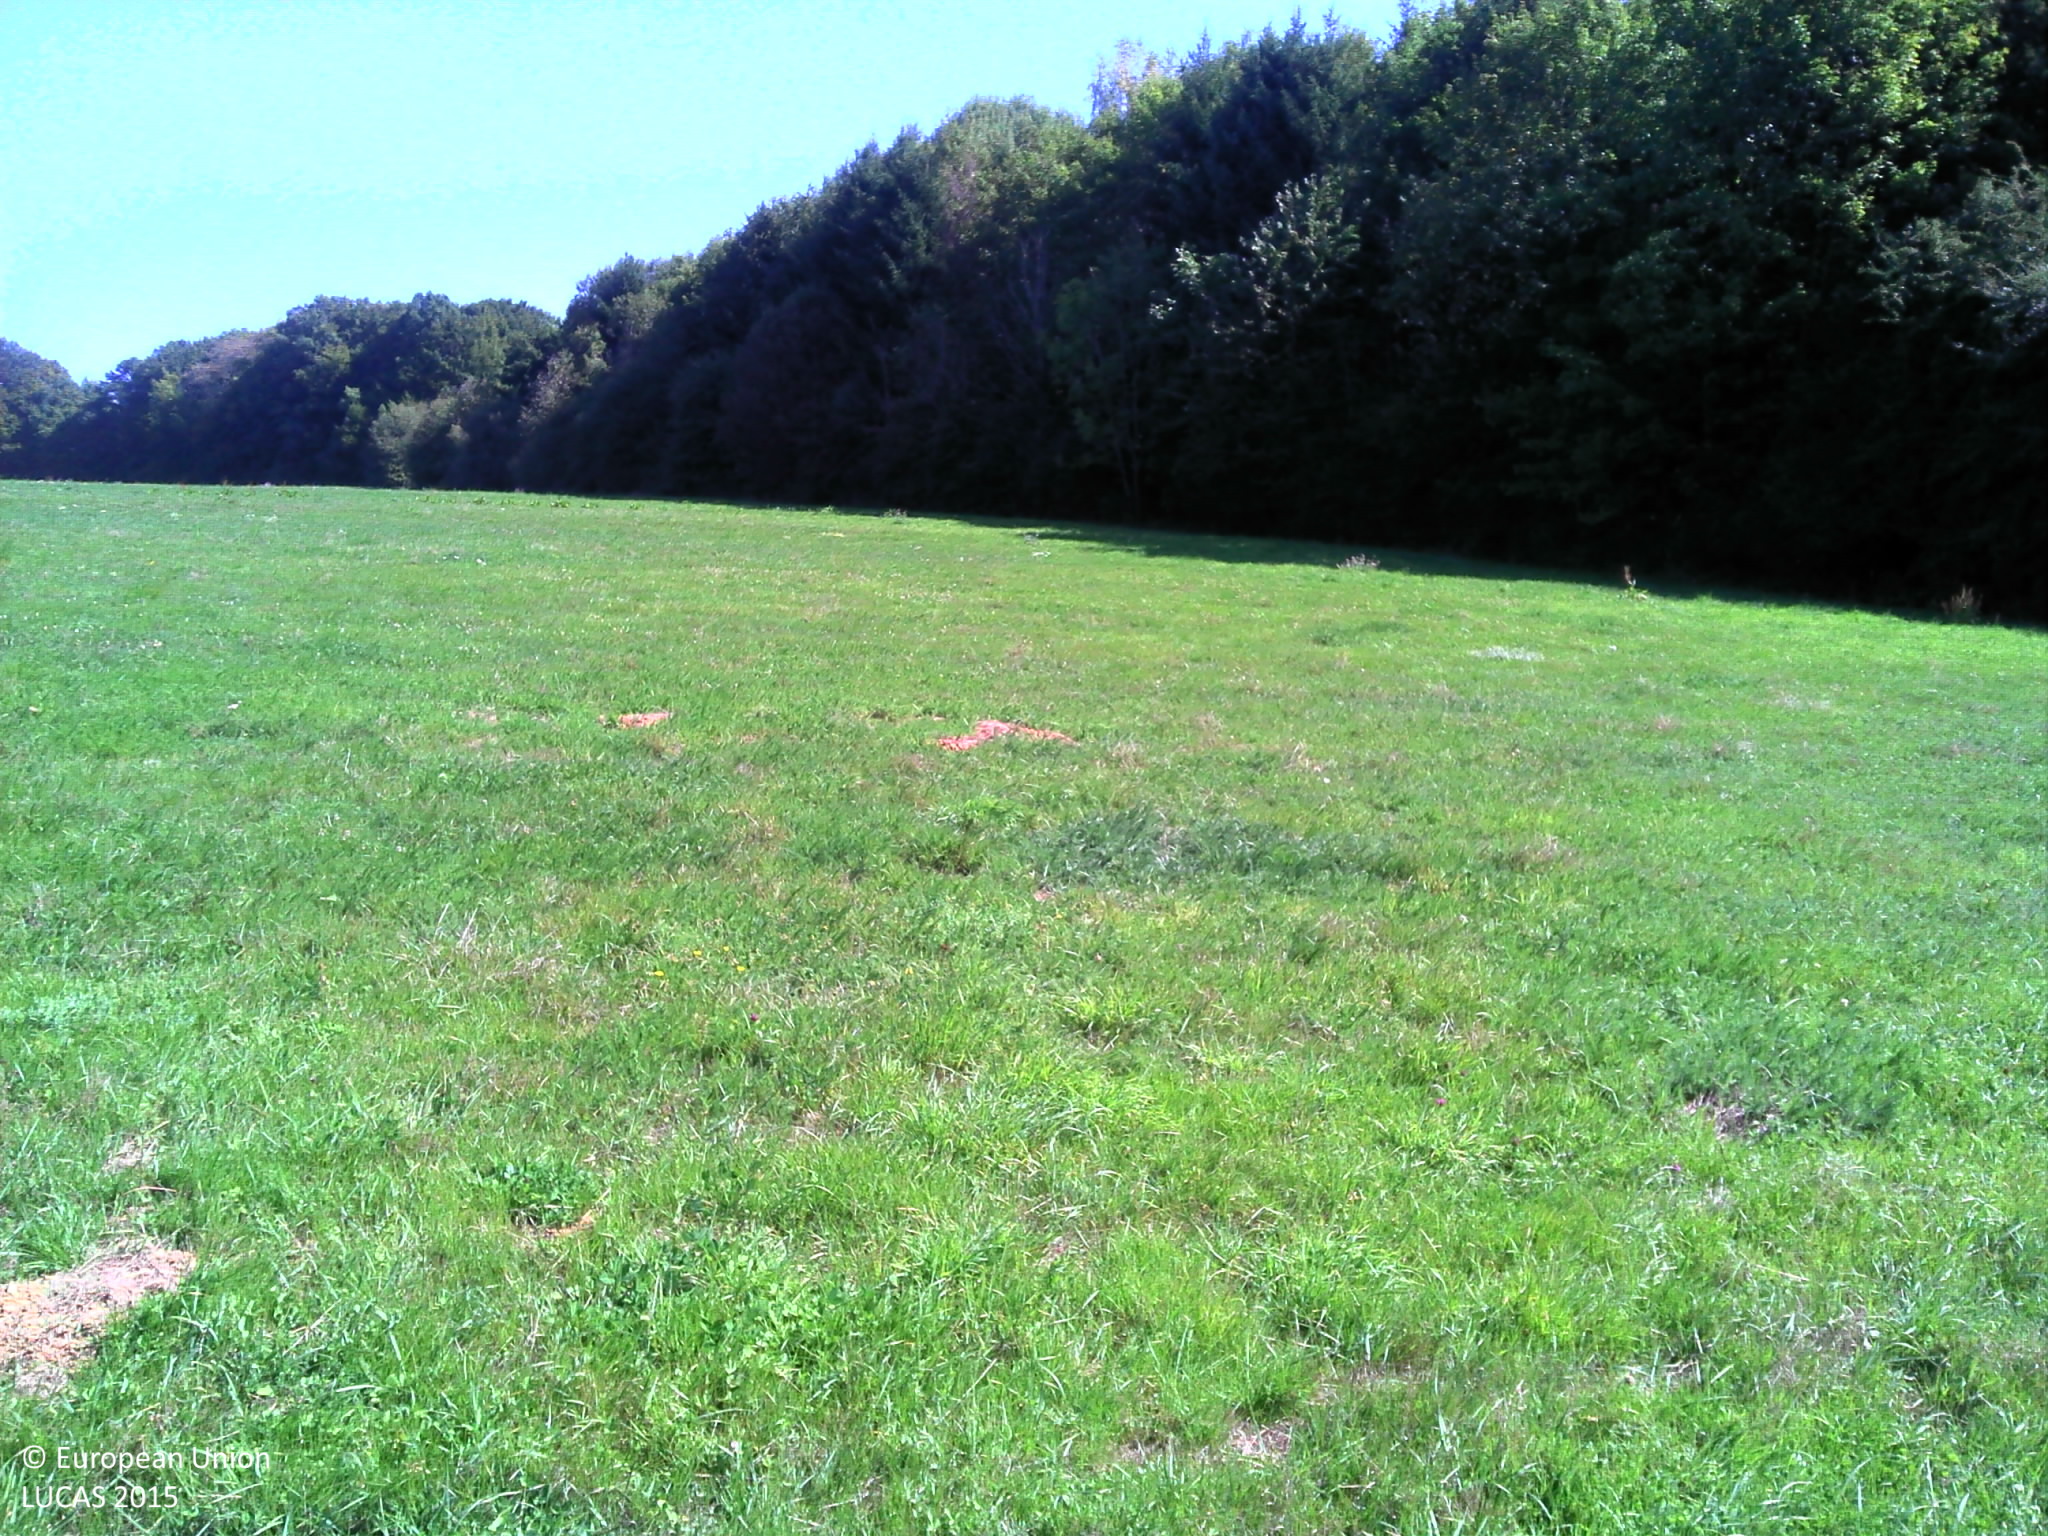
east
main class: Grassland
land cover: Grassland without tree/shrub cover
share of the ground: > 75 %
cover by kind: herbaceous plants 100 %
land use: Agriculture (excluding fallow land and kitchen gardens)
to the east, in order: Grassland without tree/shrub cover; Broadleaved woodland; Fences; Spruce dominated mixed woodland; Spruce dominated coniferous woodland; Broadleaved woodland; Dry stone walls; Tracks; Broadleaved woodland
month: September
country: FR
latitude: 47.2868
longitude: 6.0219
